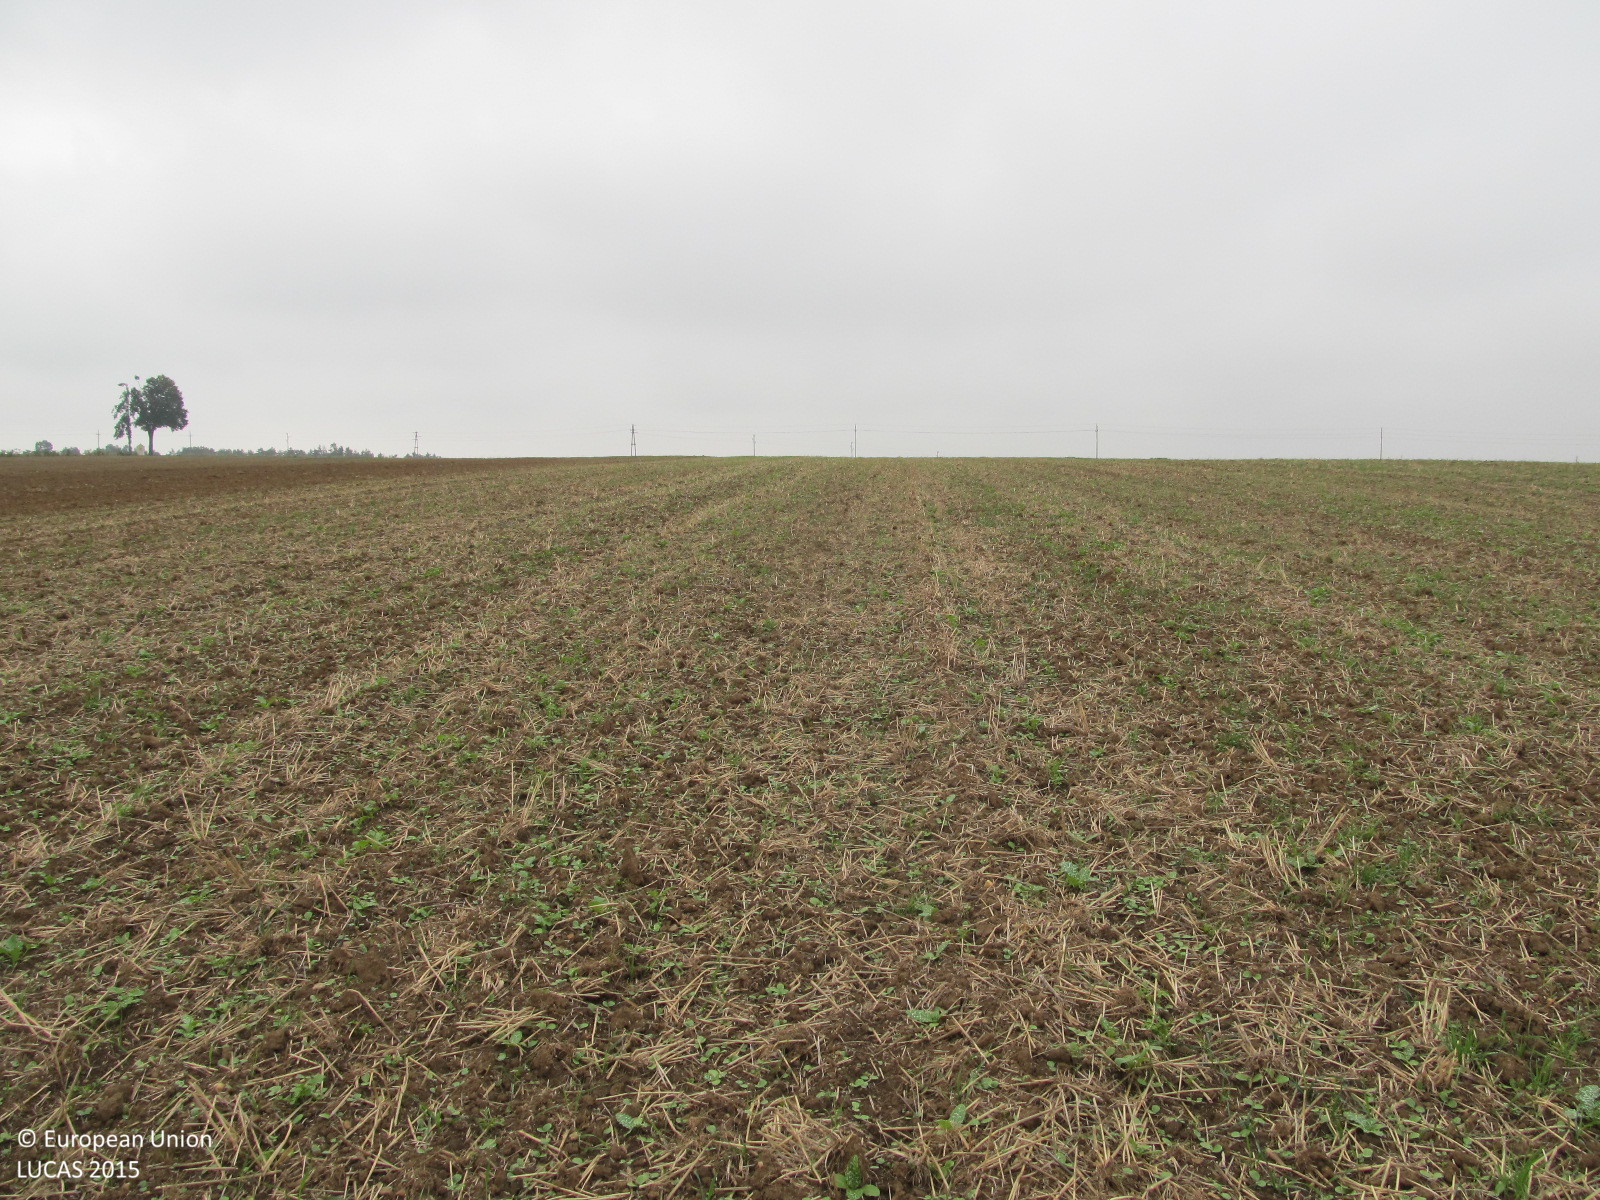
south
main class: Cropland
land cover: Common wheat
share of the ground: 25 - 50 %
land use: Agriculture (excluding fallow land and kitchen gardens)
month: September
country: AT
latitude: 48.8951
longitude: 15.5549
